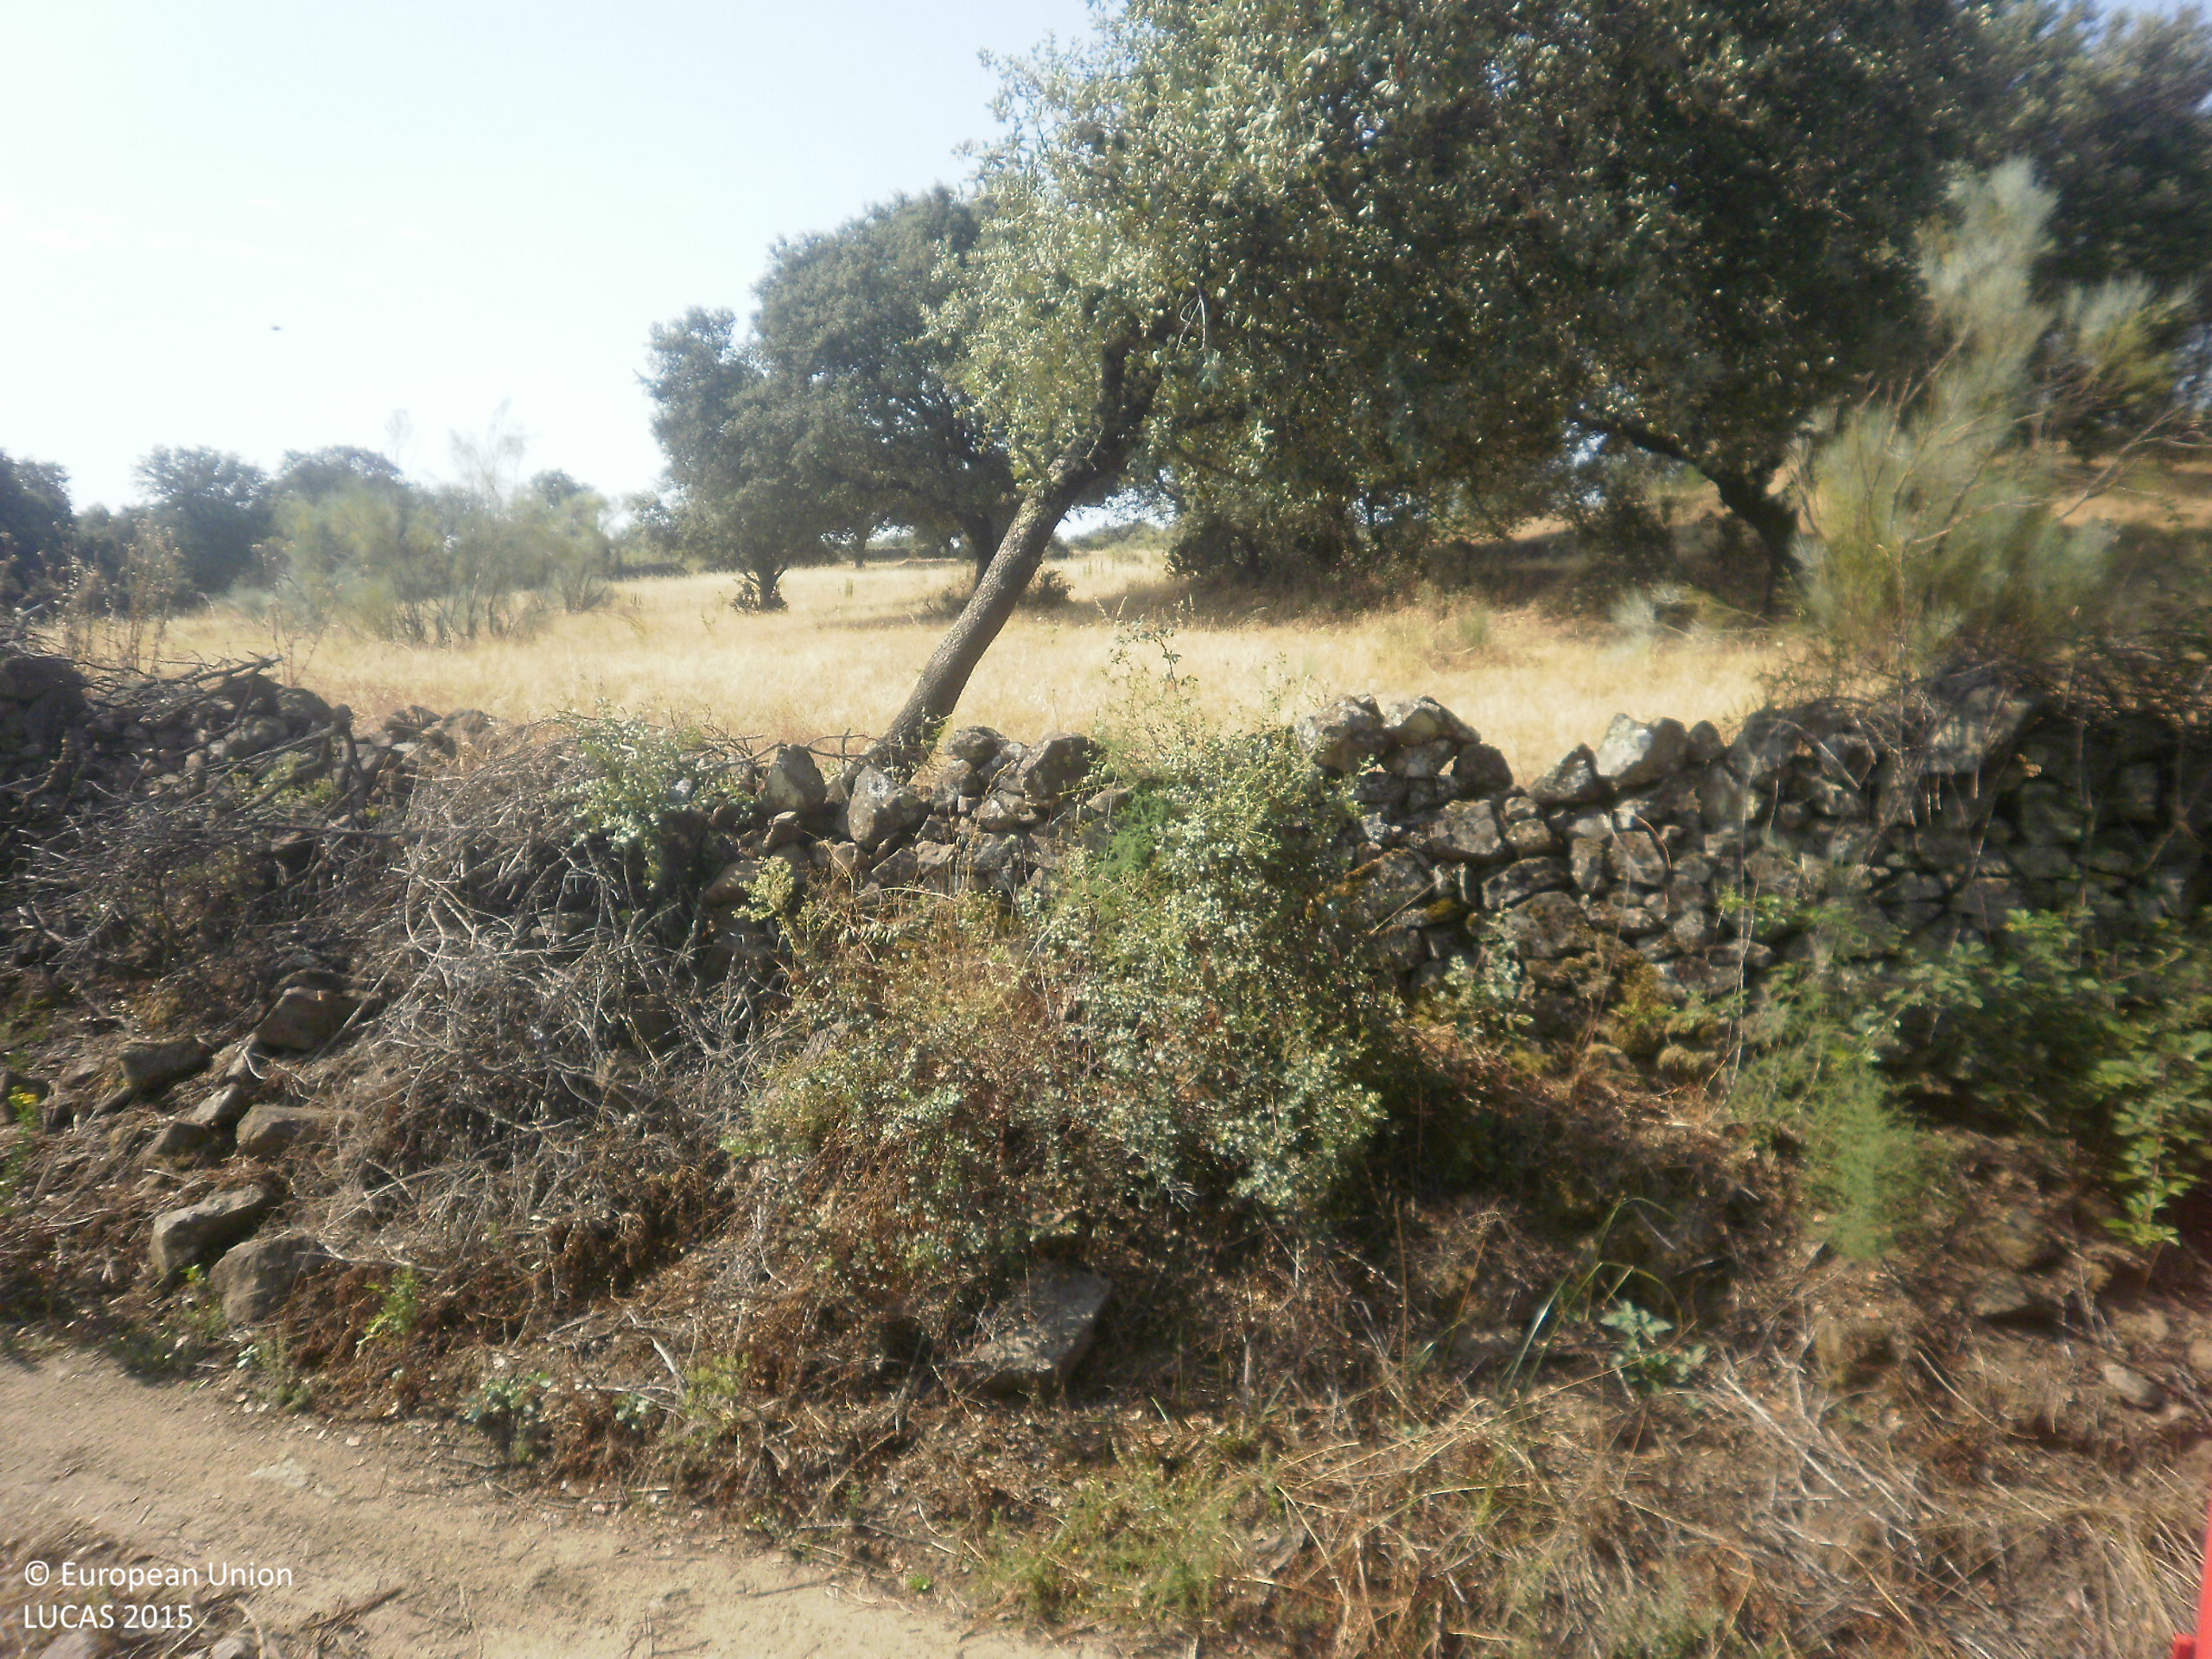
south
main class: Woodland
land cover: Broadleaved woodland
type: broadleaved evergreen forest
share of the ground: 10 - 25 %
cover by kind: herbaceous plants 80 %, broadleaved forest trees 15 %, shrubs 5 %
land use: Forestry
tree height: > 5 m
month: June
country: ES
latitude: 39.2563
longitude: -5.8967
